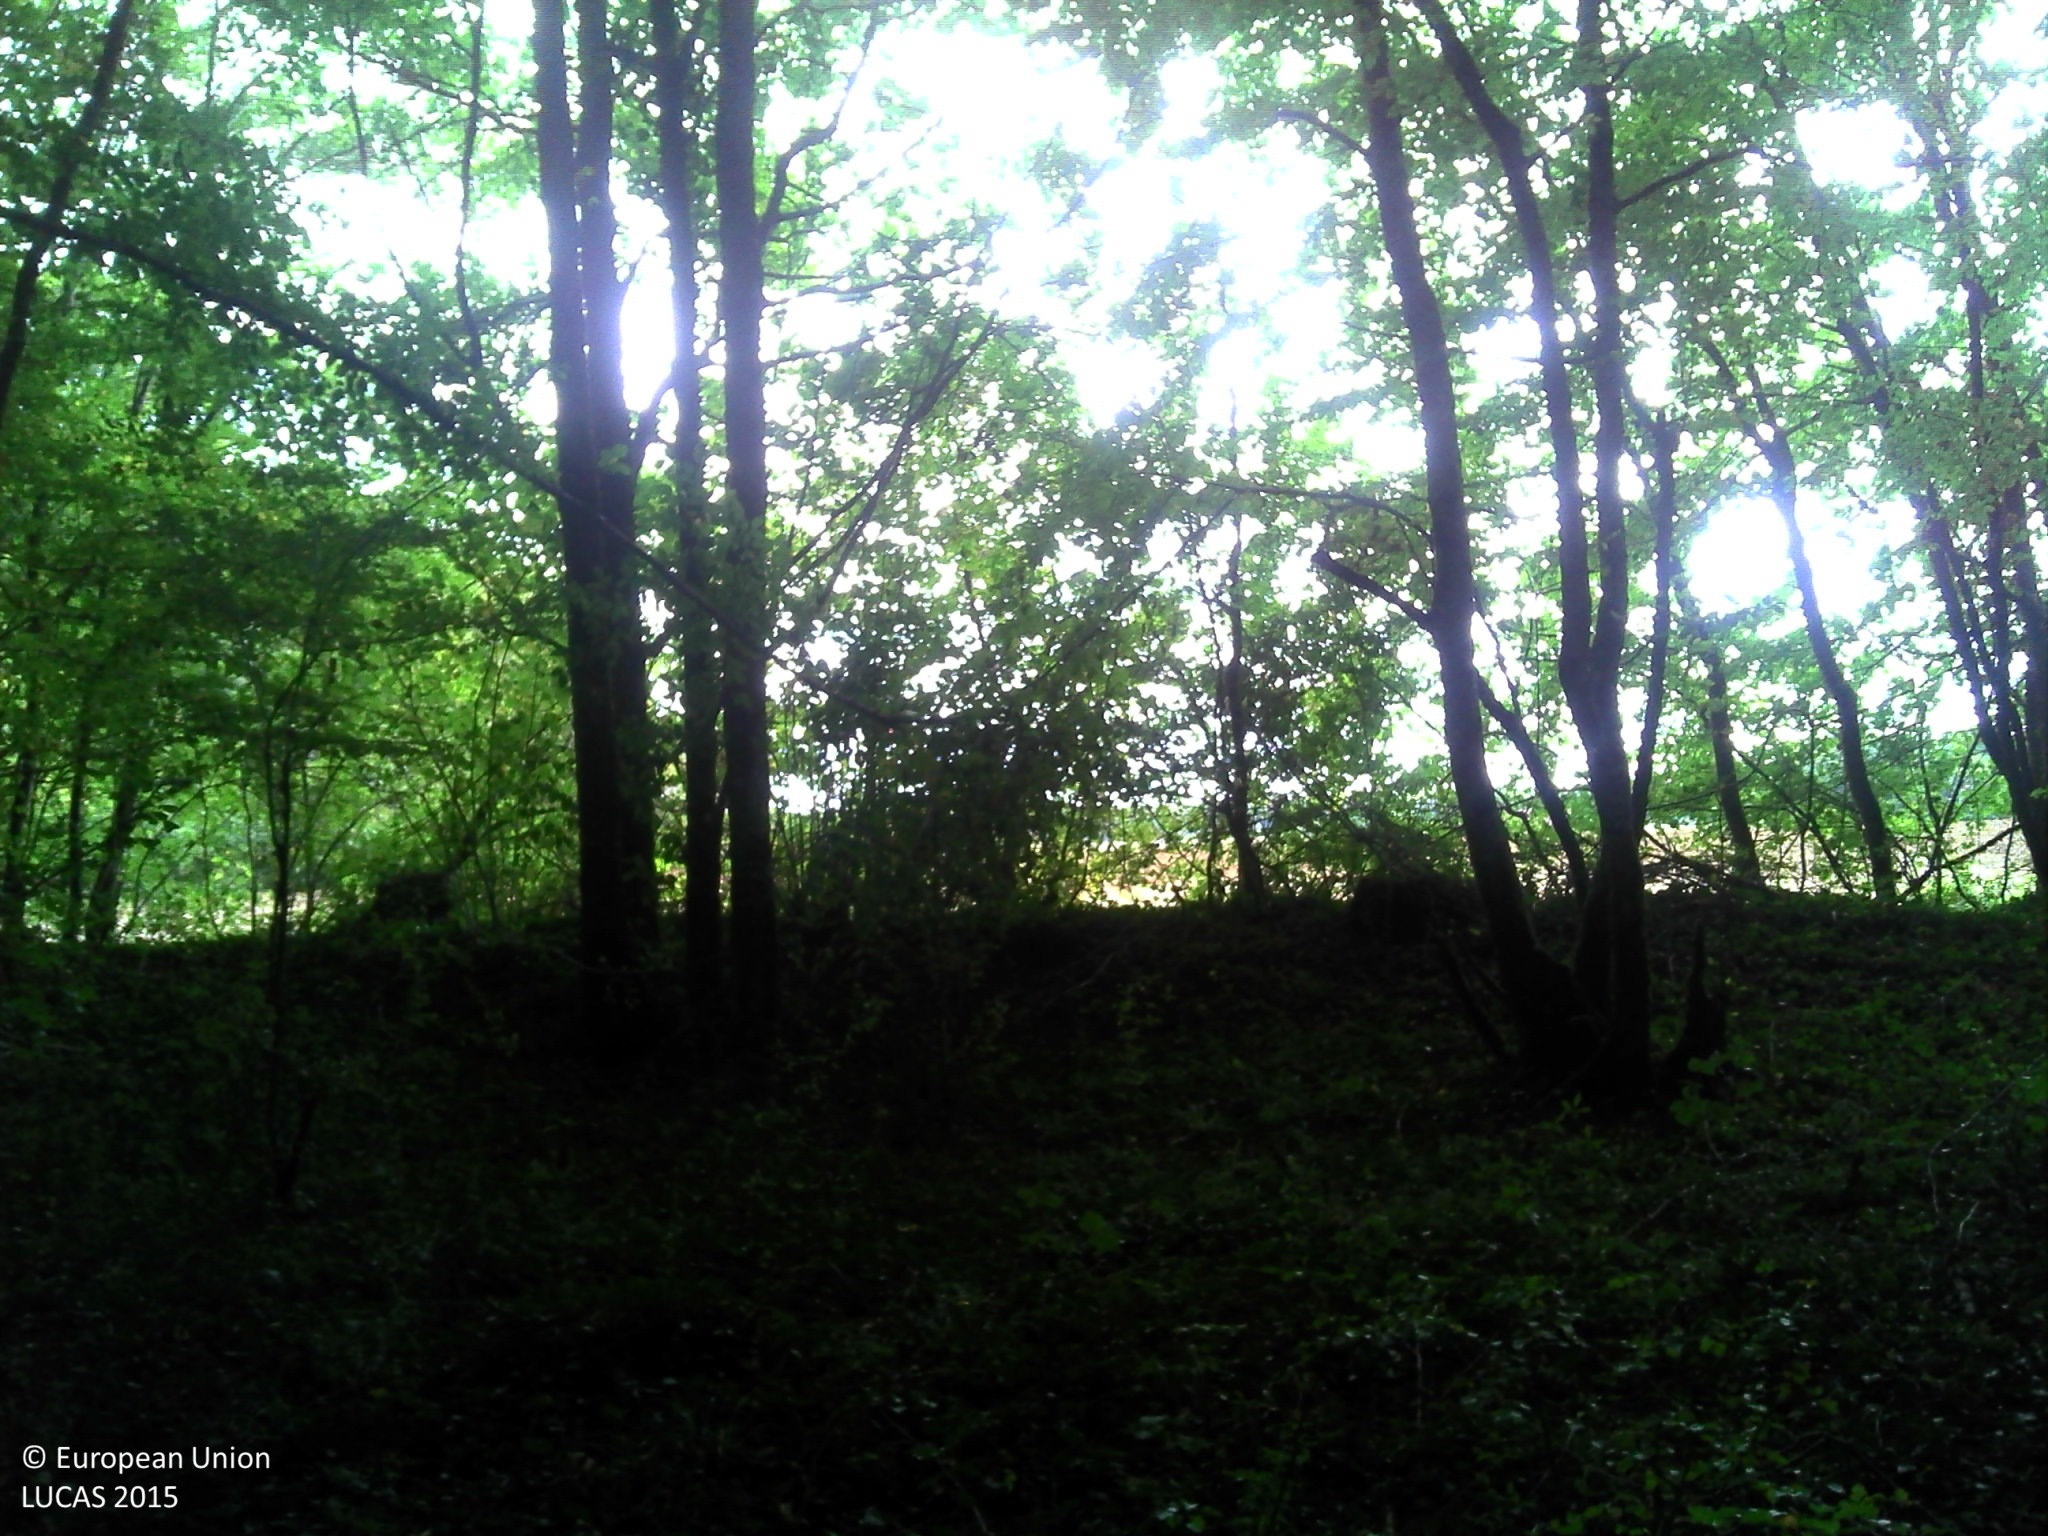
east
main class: Woodland
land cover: Broadleaved woodland
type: mesophytic deciduous forest
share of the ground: > 75 %
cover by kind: broadleaved forest trees 95 %, herbaceous plants 5 %
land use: Forestry
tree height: > 5 m
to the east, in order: Broadleaved woodland; Ditches and canals; Other bare soil; Ditches and canals; Broadleaved woodland; Ditches and canals; Other bare soil; Ditches and canals; Broadleaved woodland
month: September
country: FR
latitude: 46.7781
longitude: 1.5677
